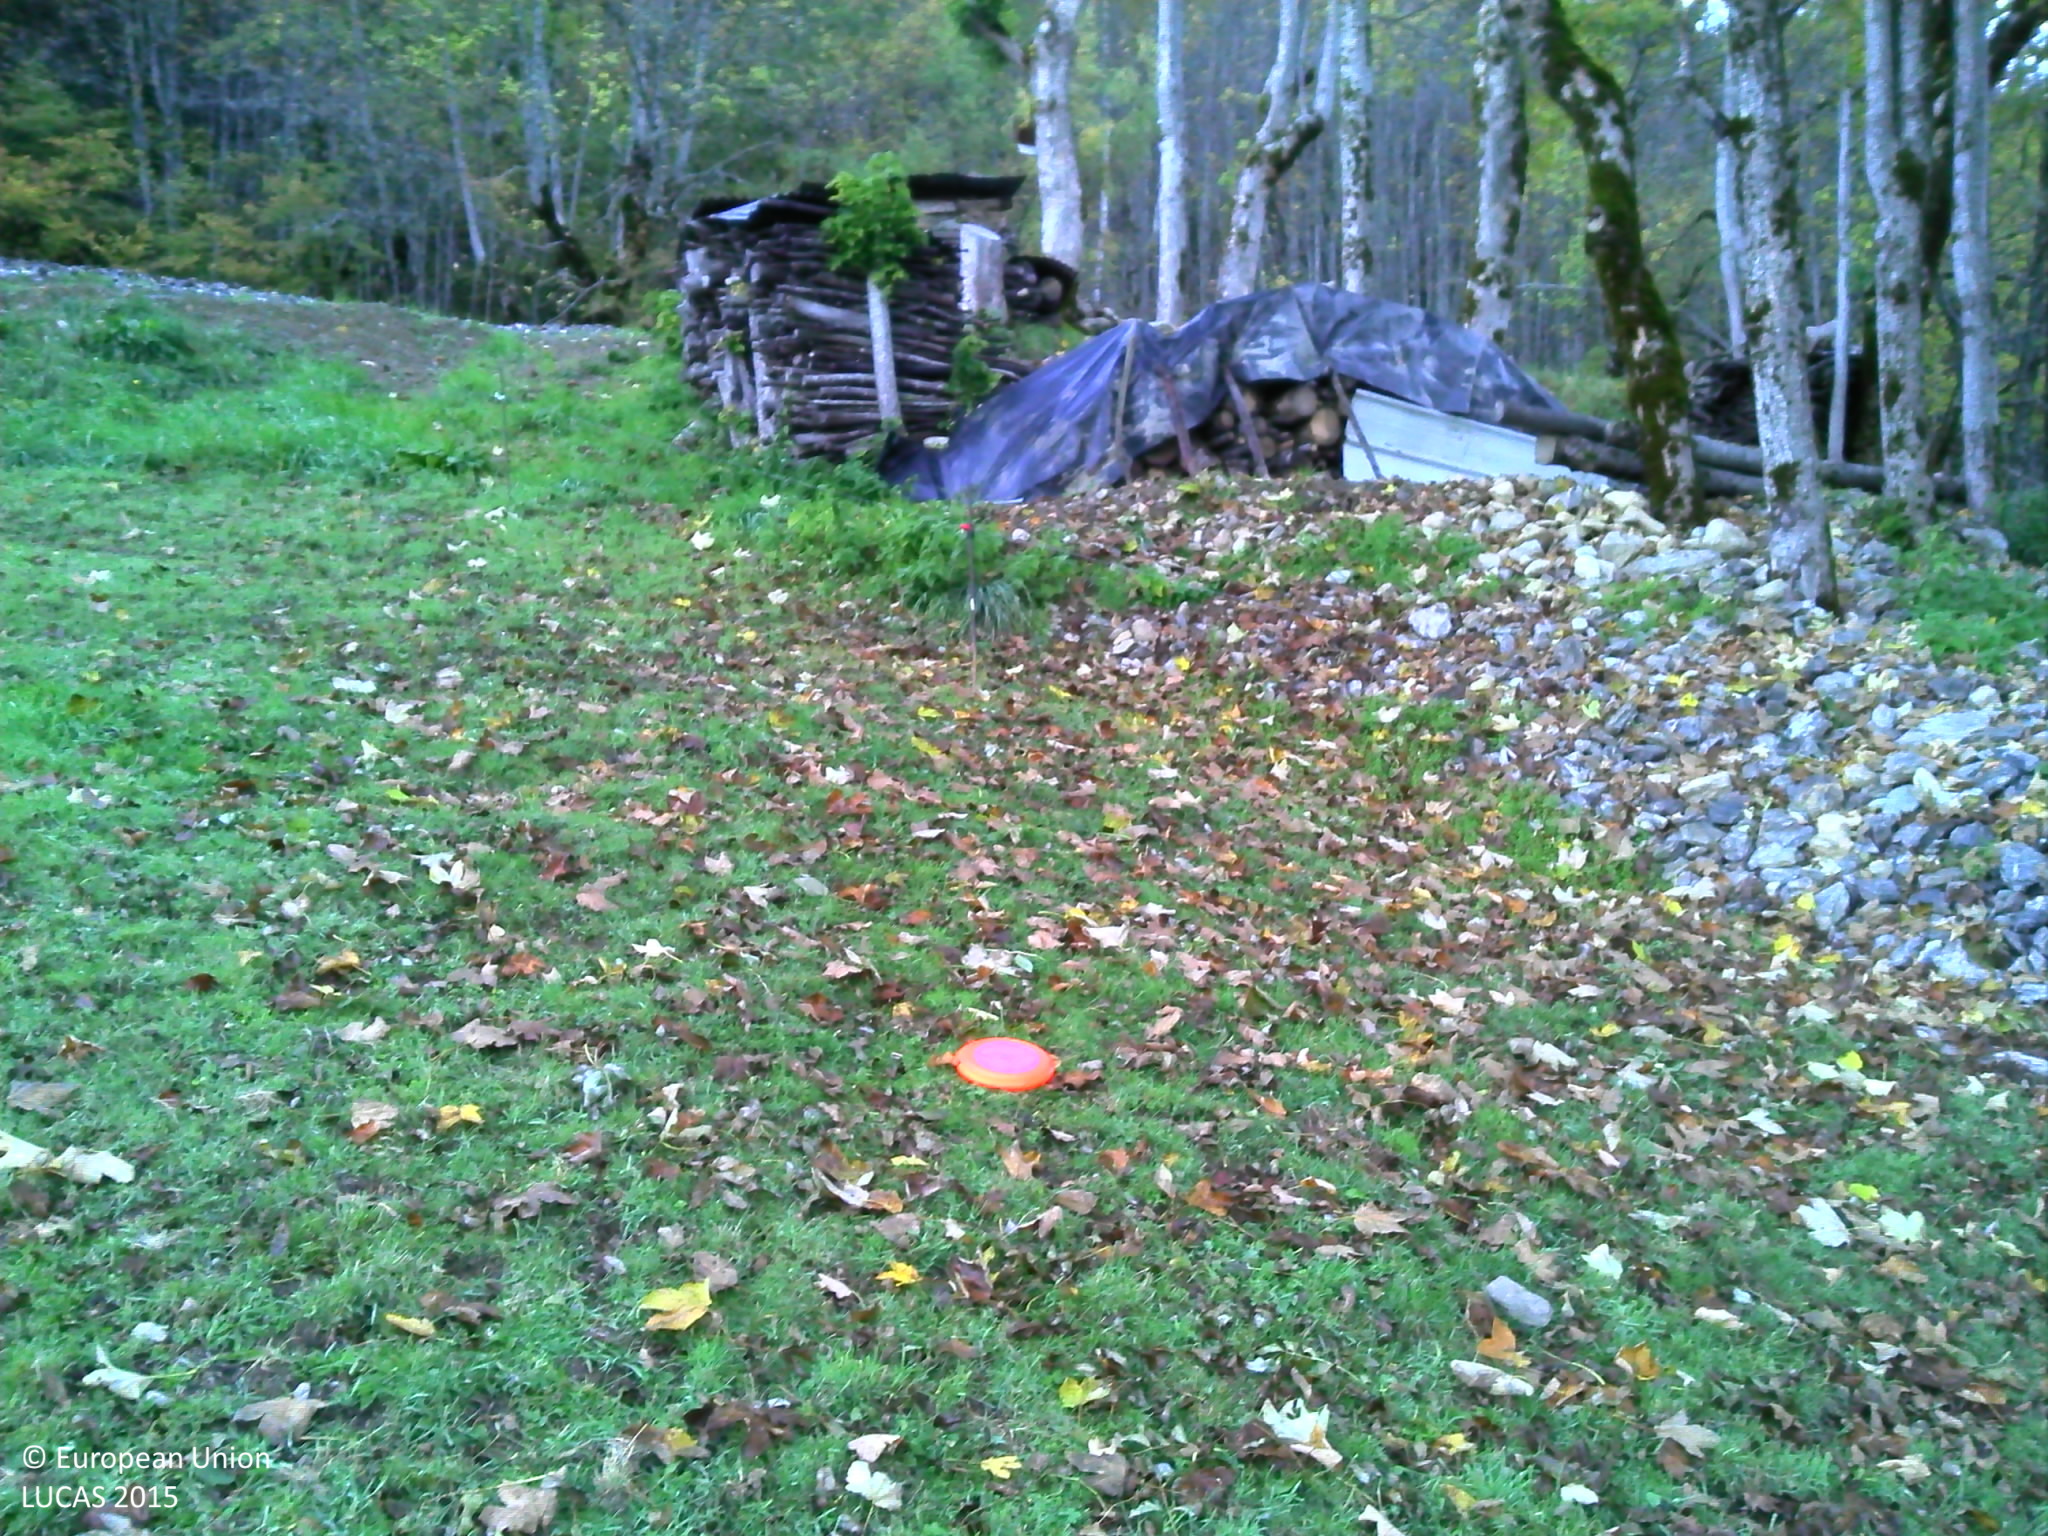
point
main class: Grassland
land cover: Grassland without tree/shrub cover
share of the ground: > 75 %
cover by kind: herbaceous plants 95 %, unconsolidated bare surface 5 %
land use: Agriculture (excluding fallow land and kitchen gardens)
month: October
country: FR
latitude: 45.5317
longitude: 6.3552
